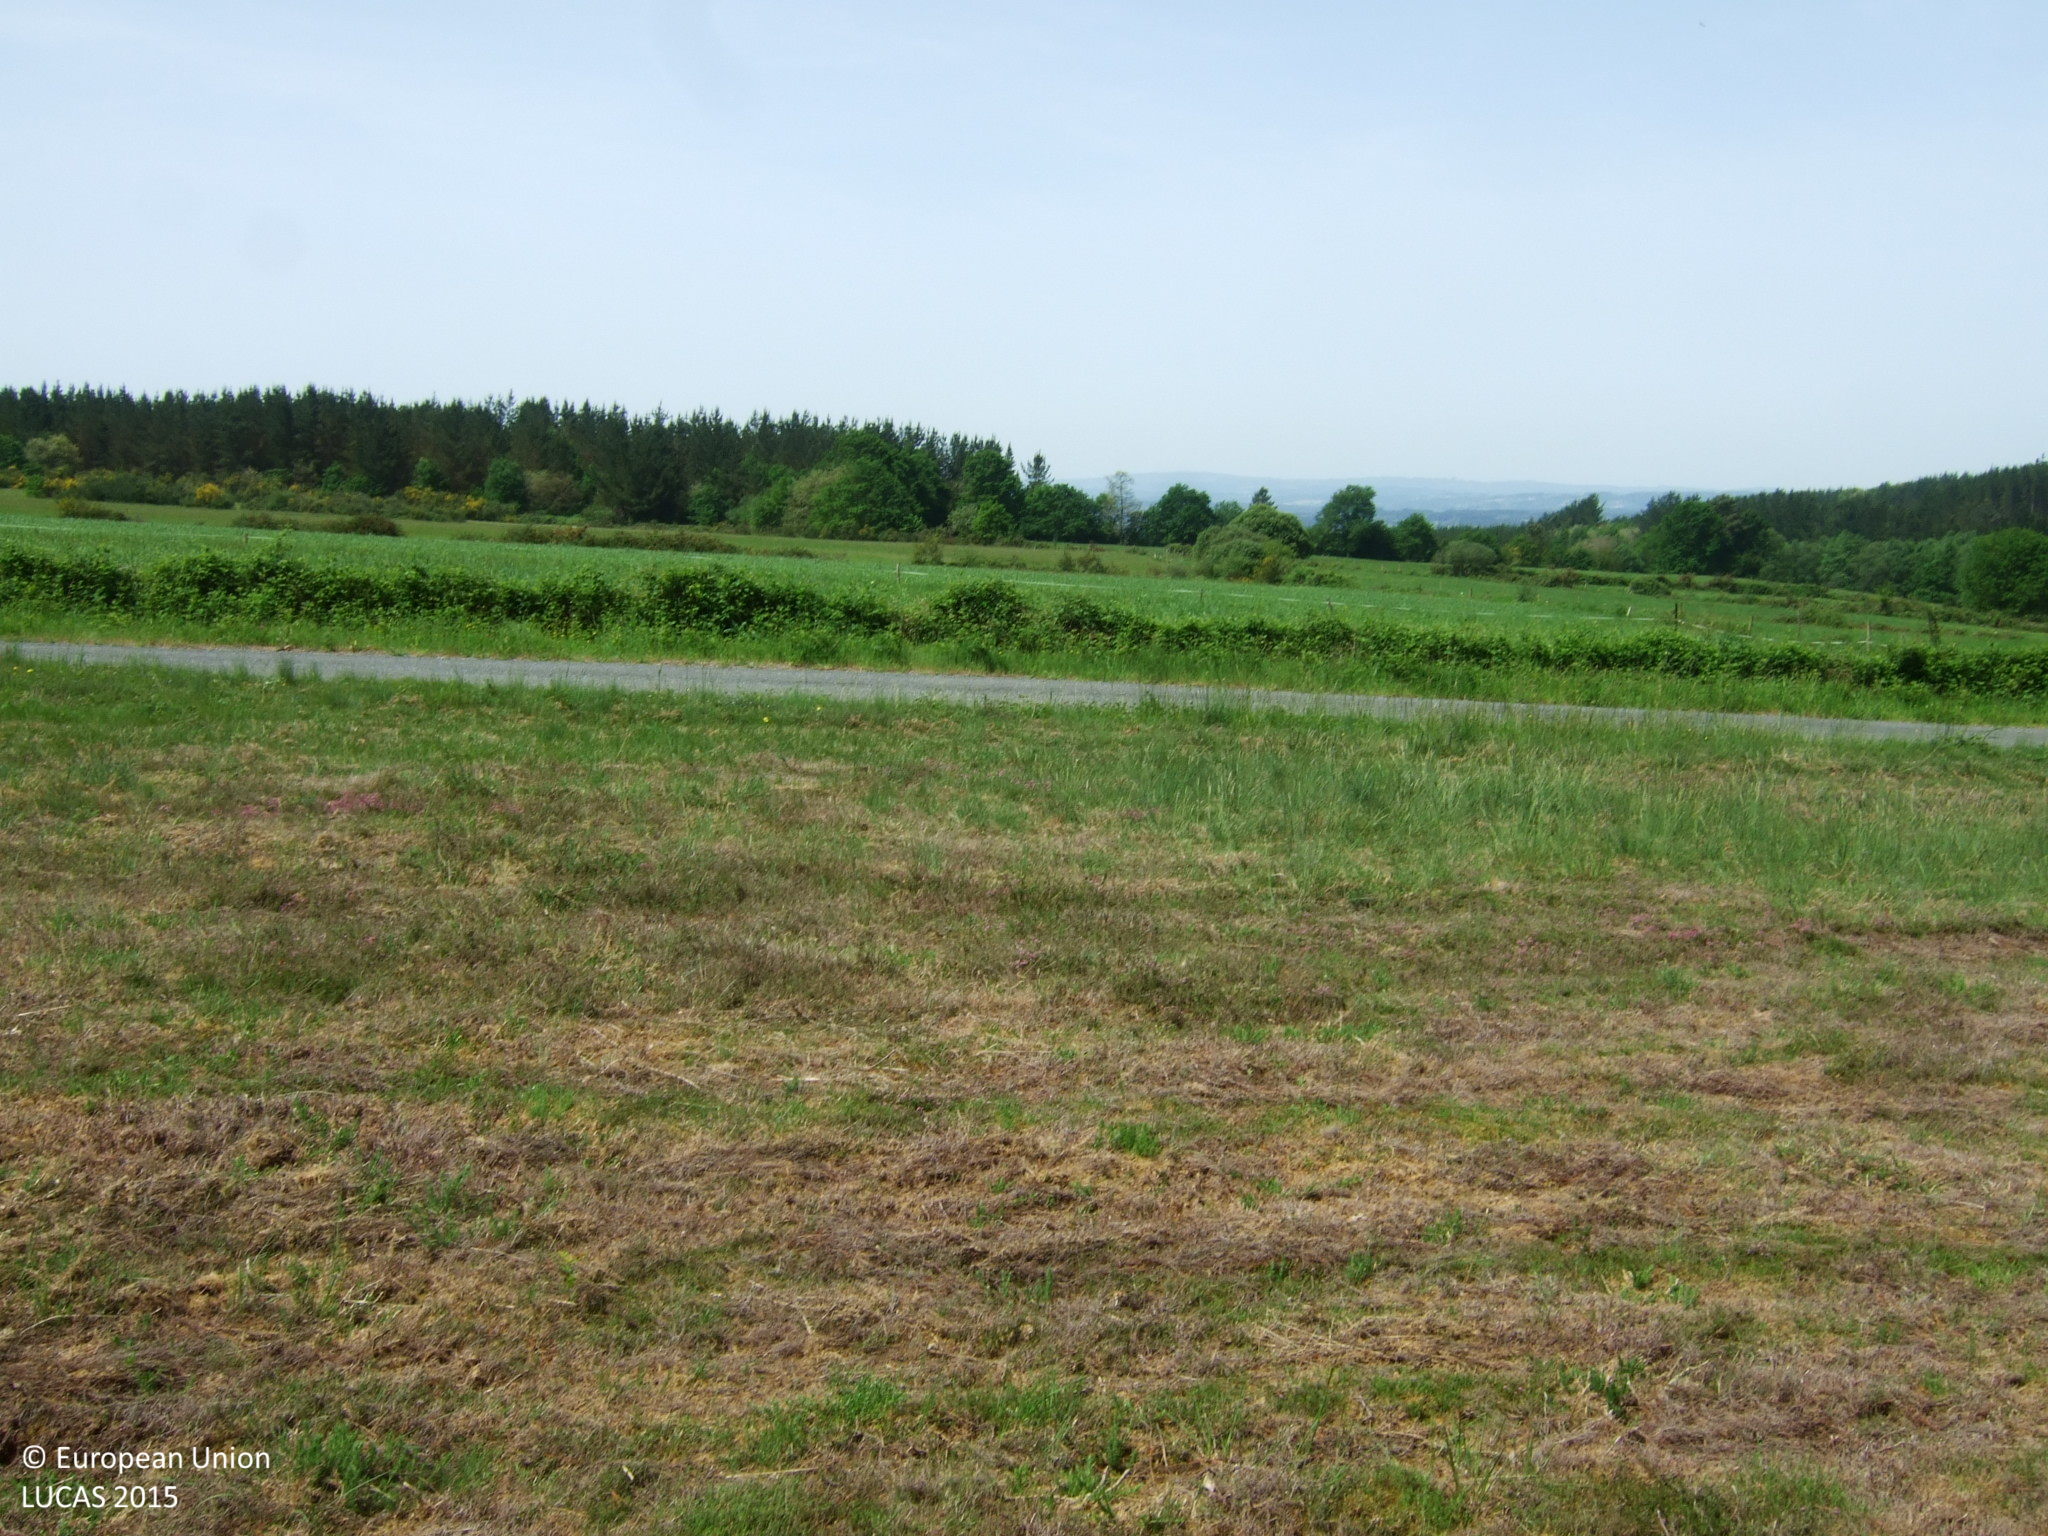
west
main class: Grassland
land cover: Grassland without tree/shrub cover
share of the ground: > 75 %
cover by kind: herbaceous plants 100 %
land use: Agriculture (excluding fallow land and kitchen gardens)
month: May
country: ES
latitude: 42.8856
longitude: -7.3966
